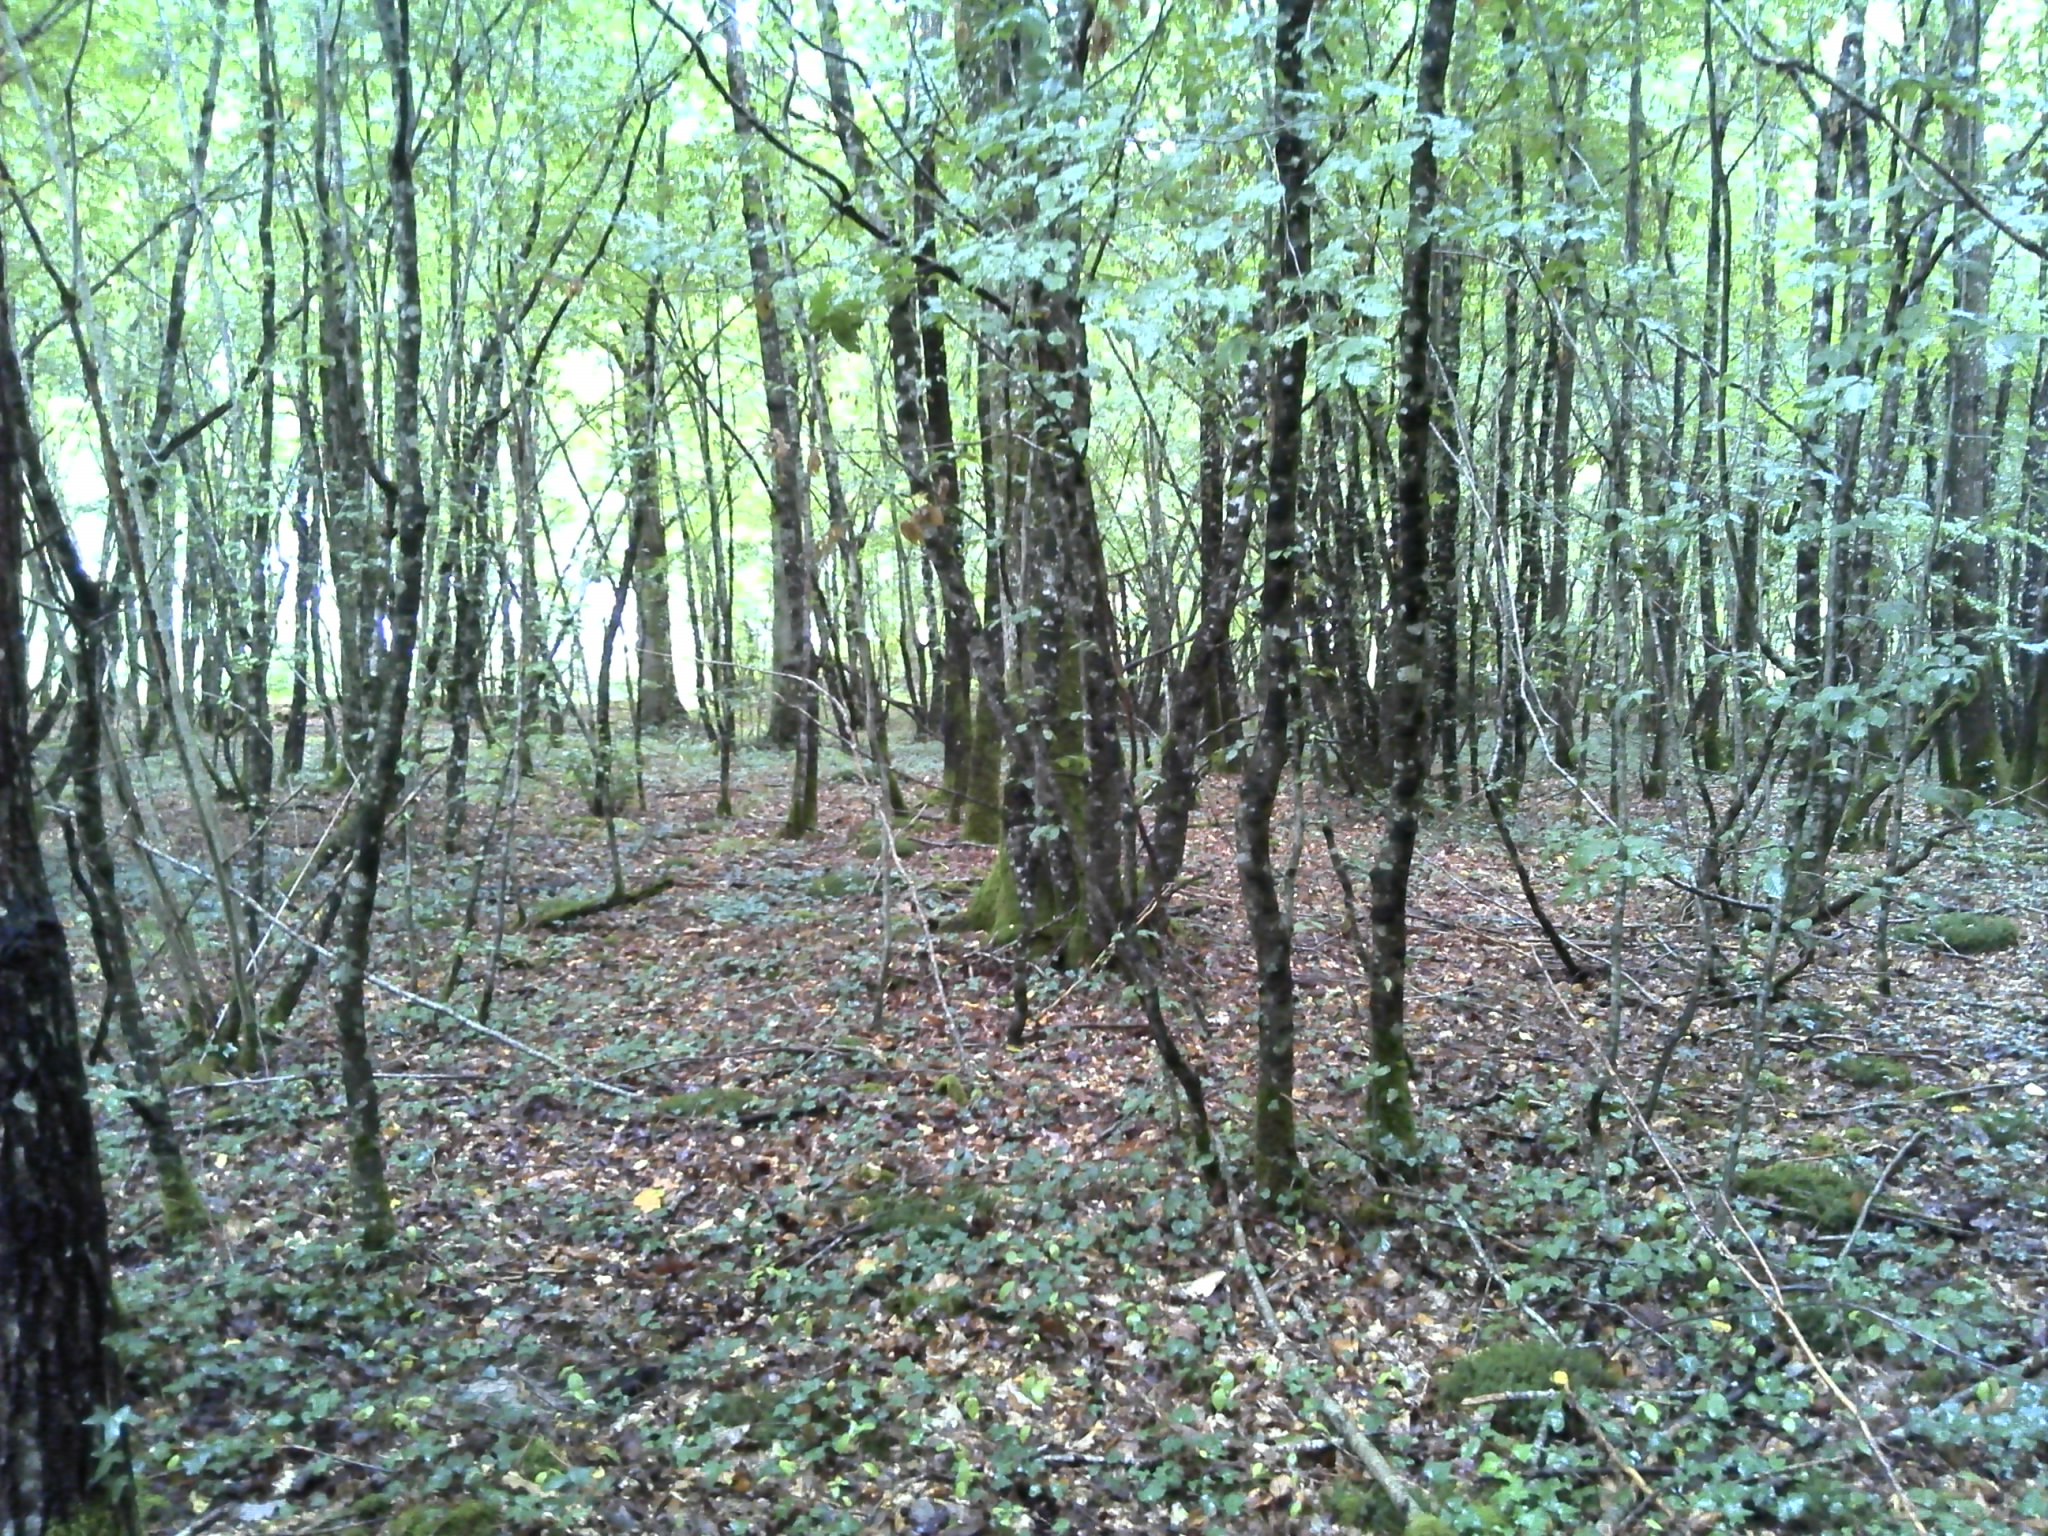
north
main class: Woodland
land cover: Broadleaved woodland
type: mesophytic deciduous forest
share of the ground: > 75 %
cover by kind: broadleaved forest trees 95 %, herbaceous plants 5 %
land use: Forestry
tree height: > 5 m
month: August
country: FR
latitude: 46.7225
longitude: 1.5502
